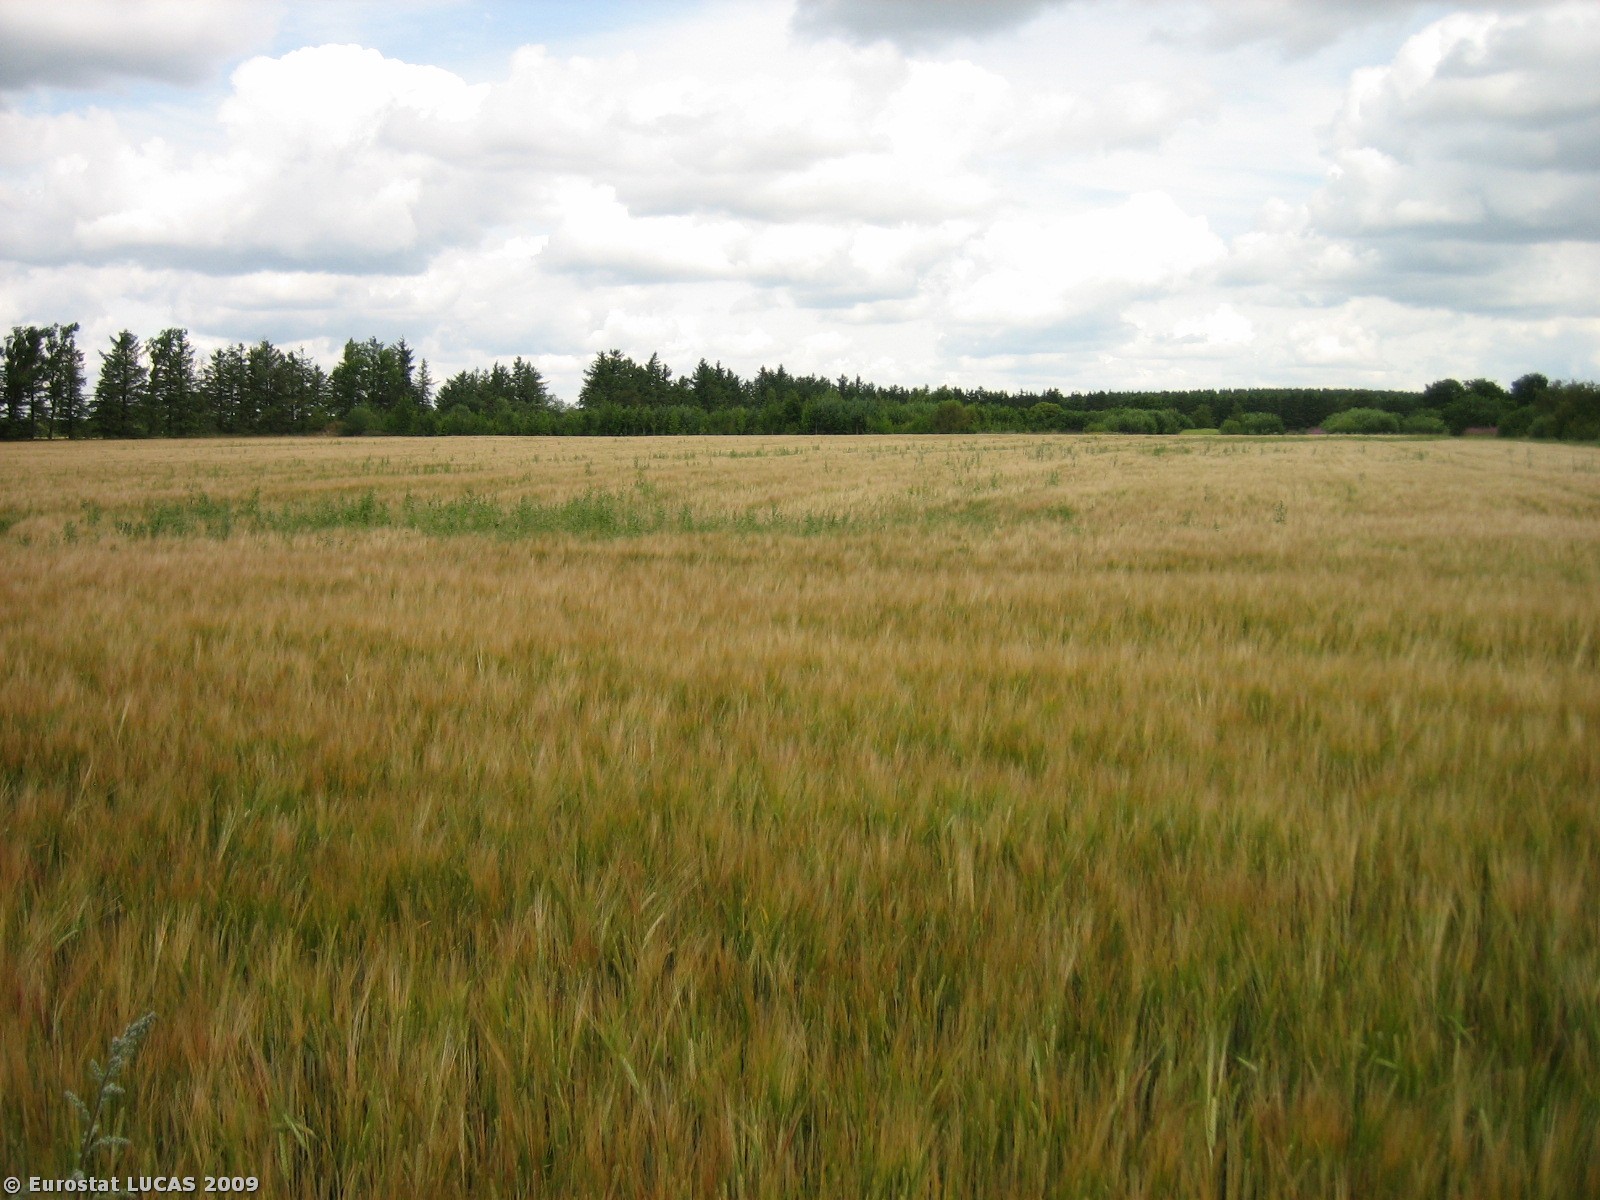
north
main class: Cropland
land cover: Barley
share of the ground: > 75 %
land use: Agriculture (excluding fallow land and kitchen gardens)
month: July
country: DK
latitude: 55.7883
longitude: 8.9963
